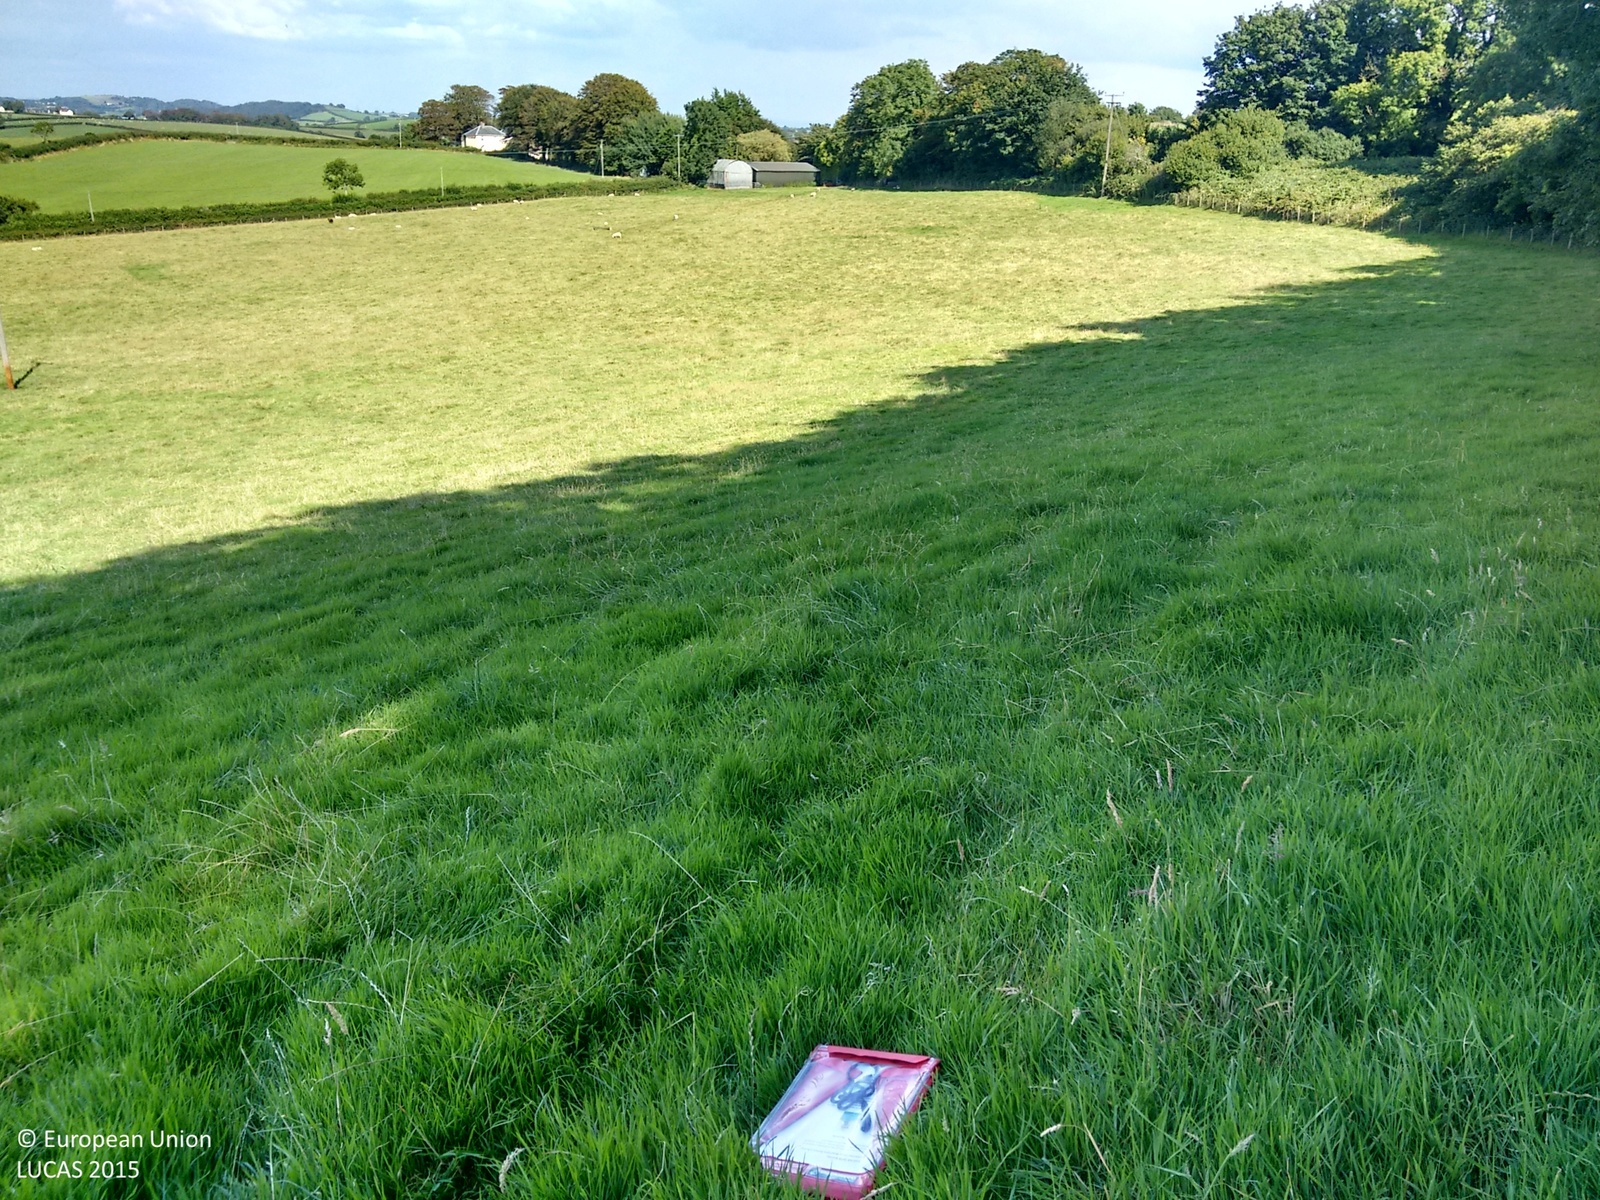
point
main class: Grassland
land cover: Grassland without tree/shrub cover
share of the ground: > 75 %
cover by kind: herbaceous plants 100 %
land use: Agriculture (excluding fallow land and kitchen gardens)
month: August
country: GB
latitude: 51.7736
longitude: -4.4966
